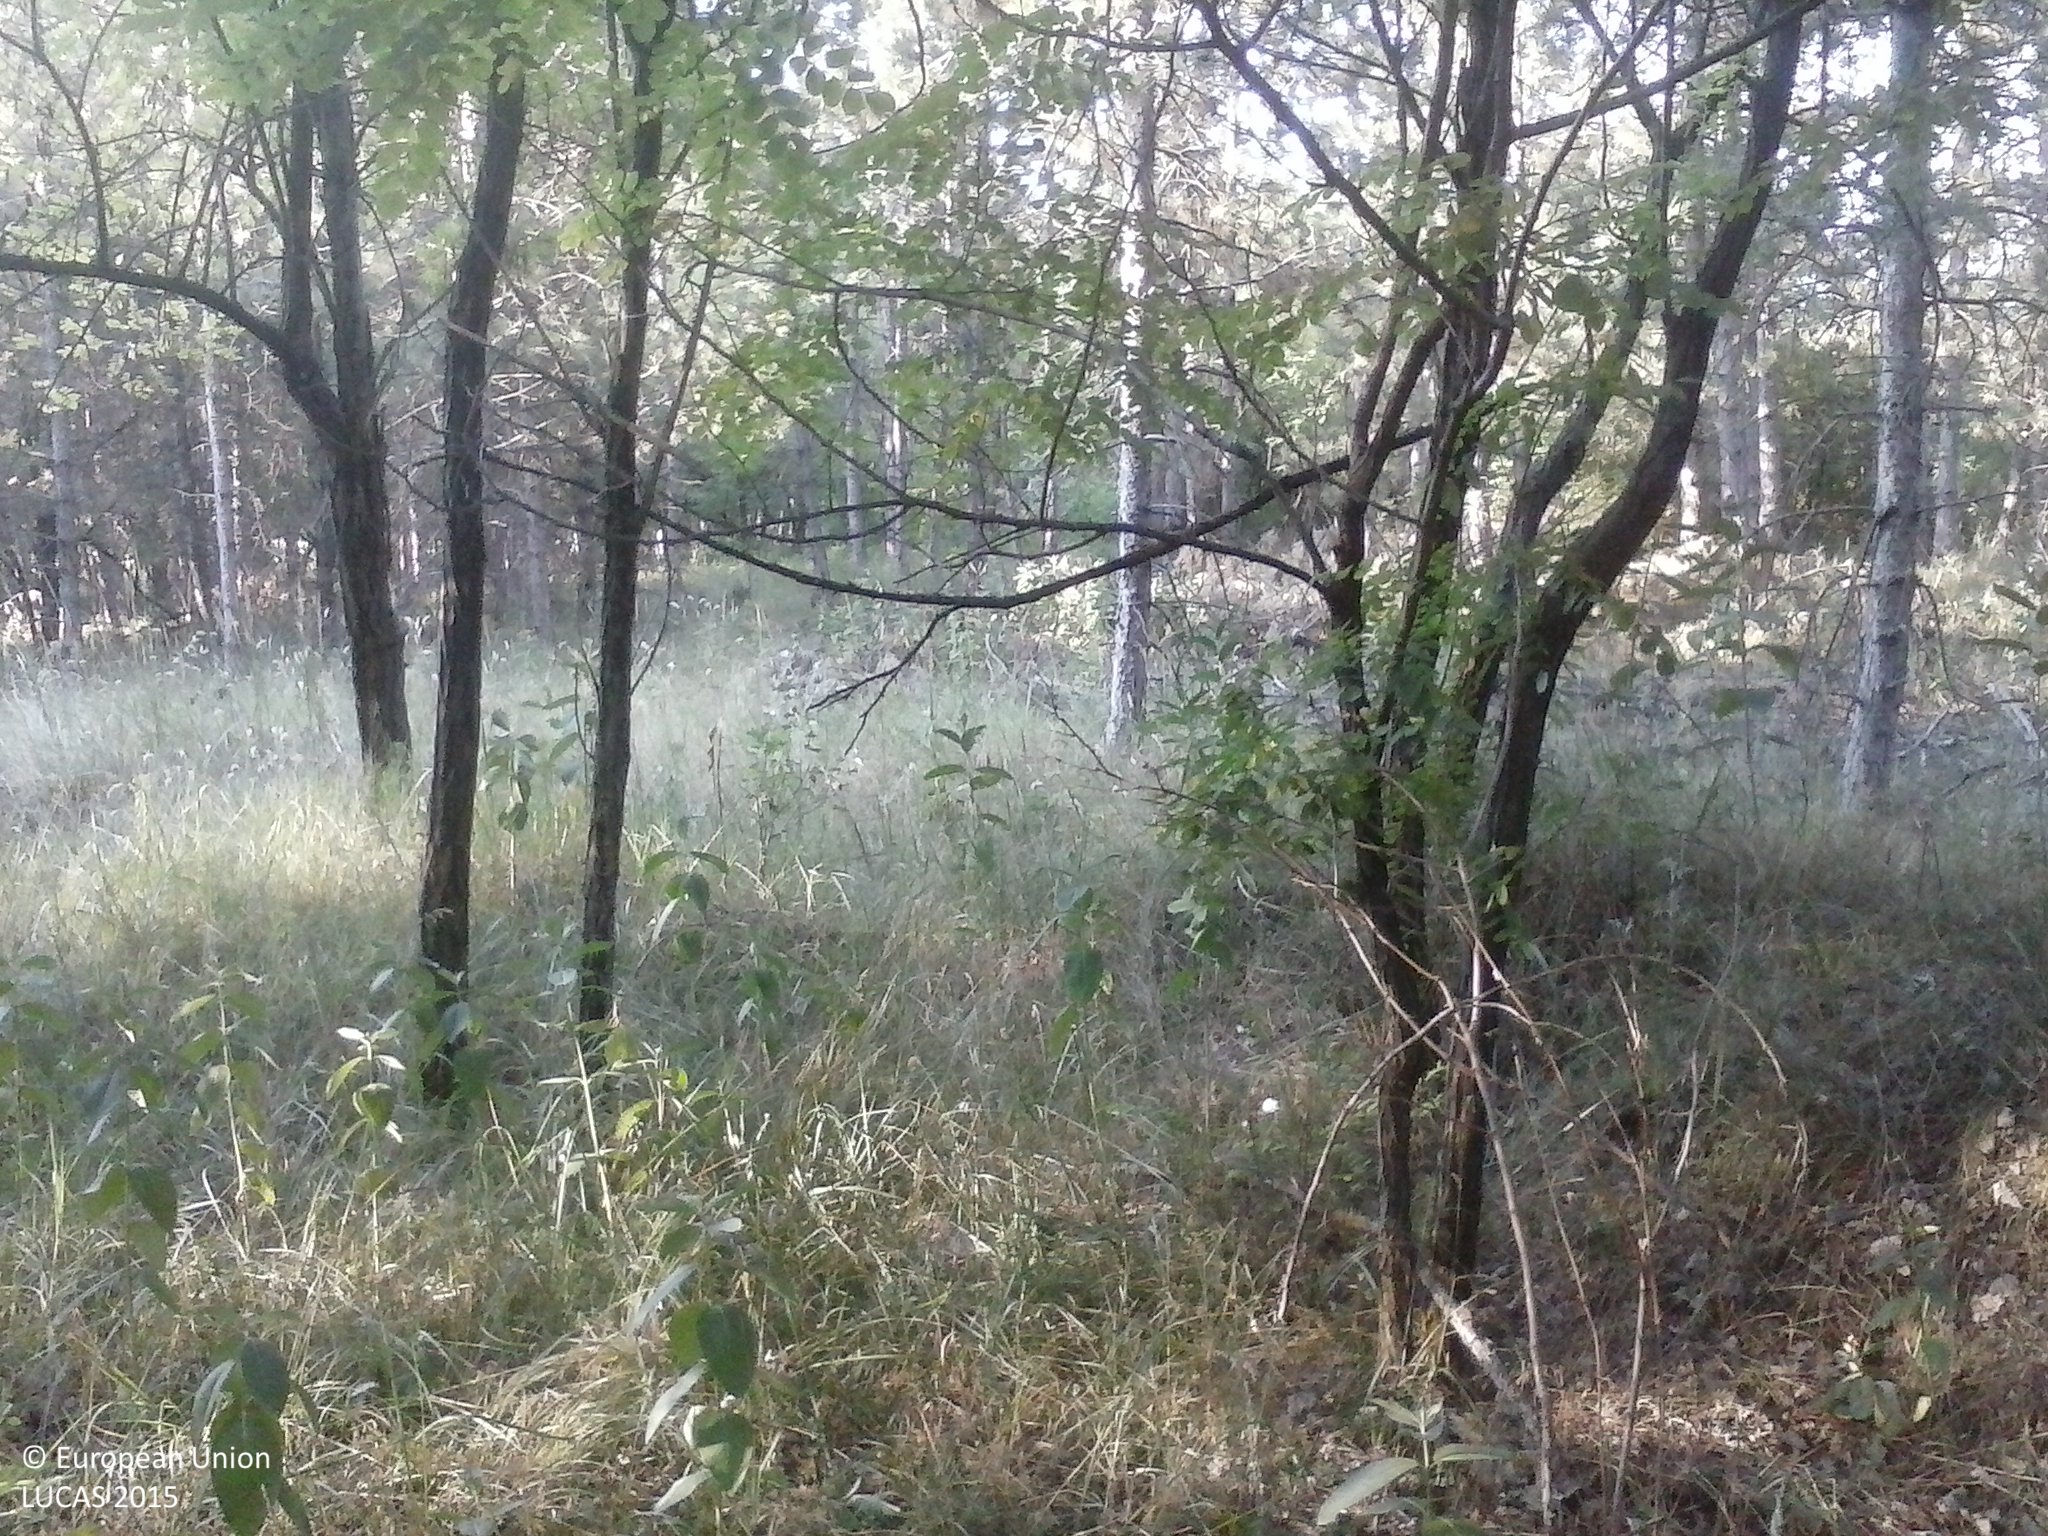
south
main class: Woodland
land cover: Pine dominated coniferous woodland
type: hemiboreal forest and nemoral coniferous forest and mixed broadleaved-coniferous forest
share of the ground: > 75 %
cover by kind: coniferous forest trees 80 %, broadleaved forest trees 10 %, shrubs 5 %, herbaceous plants 5 %
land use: Forestry
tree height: > 5 m
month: July
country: HU
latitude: 46.4053
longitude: 19.6308
